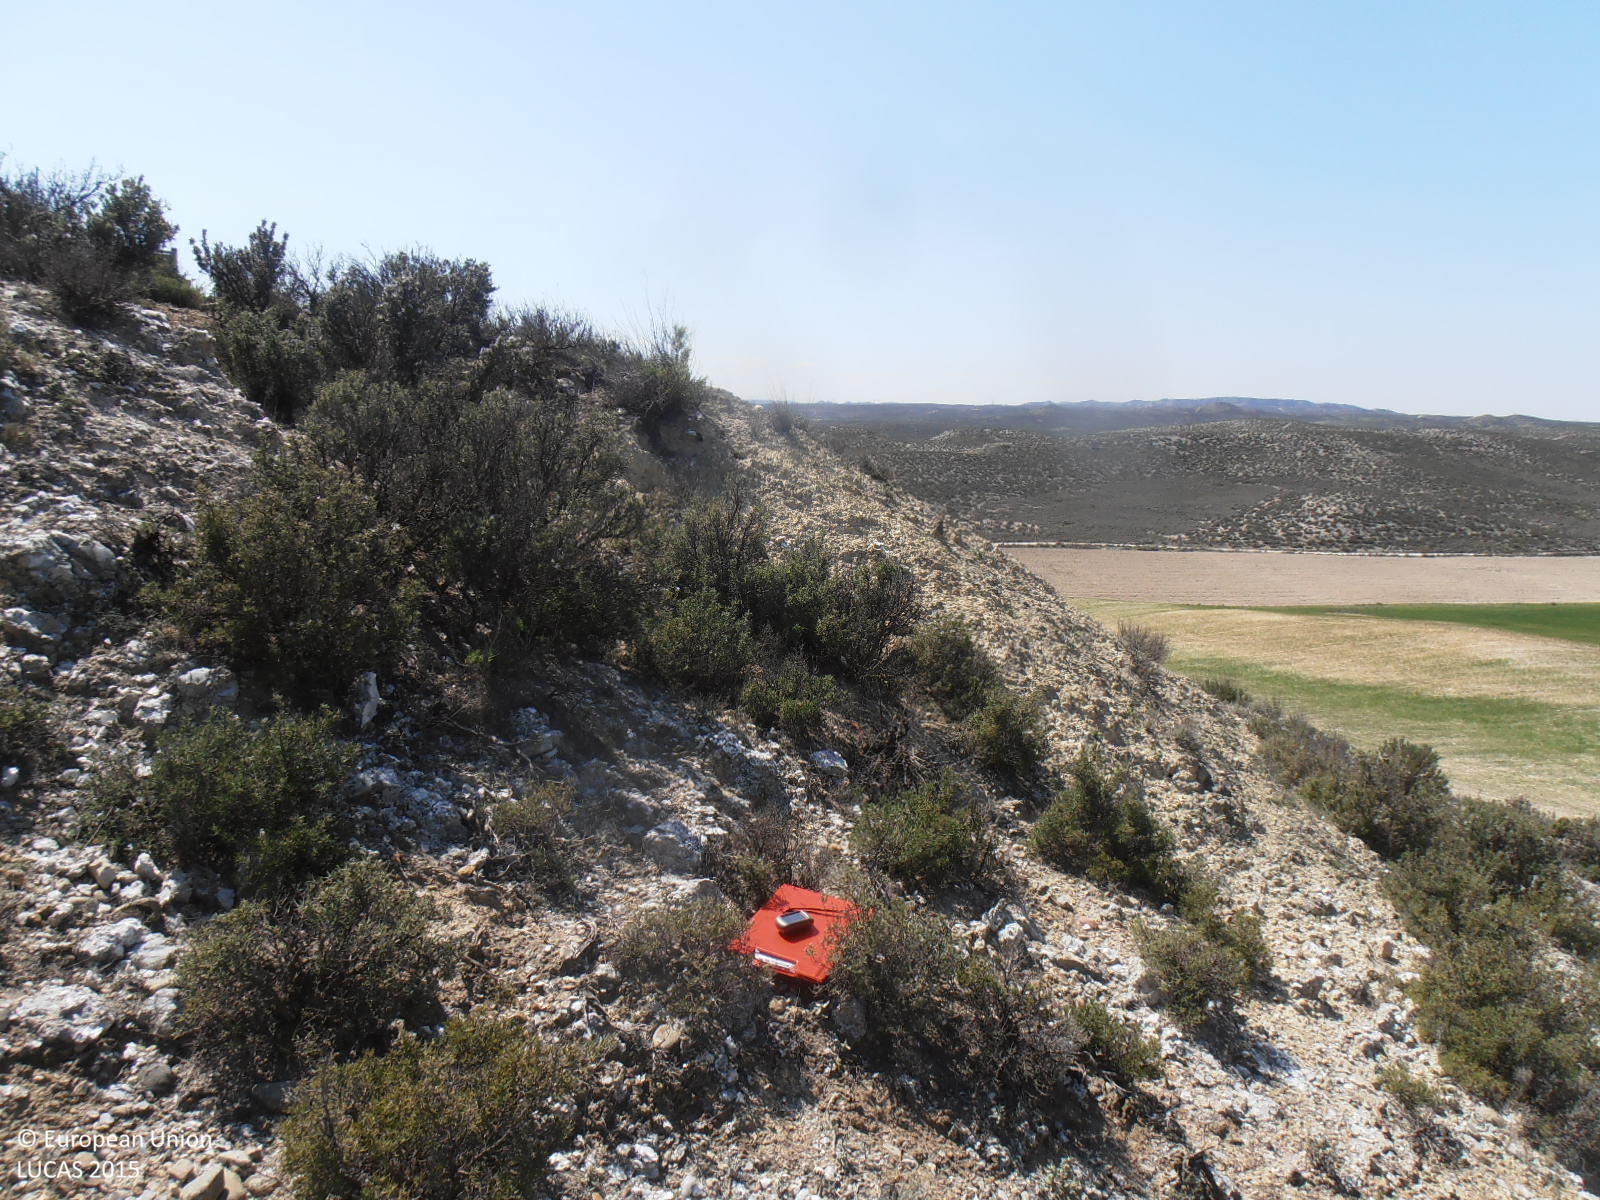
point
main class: Shrubland
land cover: Shrubland without tree cover
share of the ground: > 75 %
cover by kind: shrubs 60 %, consolidated bare surface 40 %
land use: Semi-natural and natural areas not in use
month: April
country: ES
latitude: 41.6029
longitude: -0.9525
